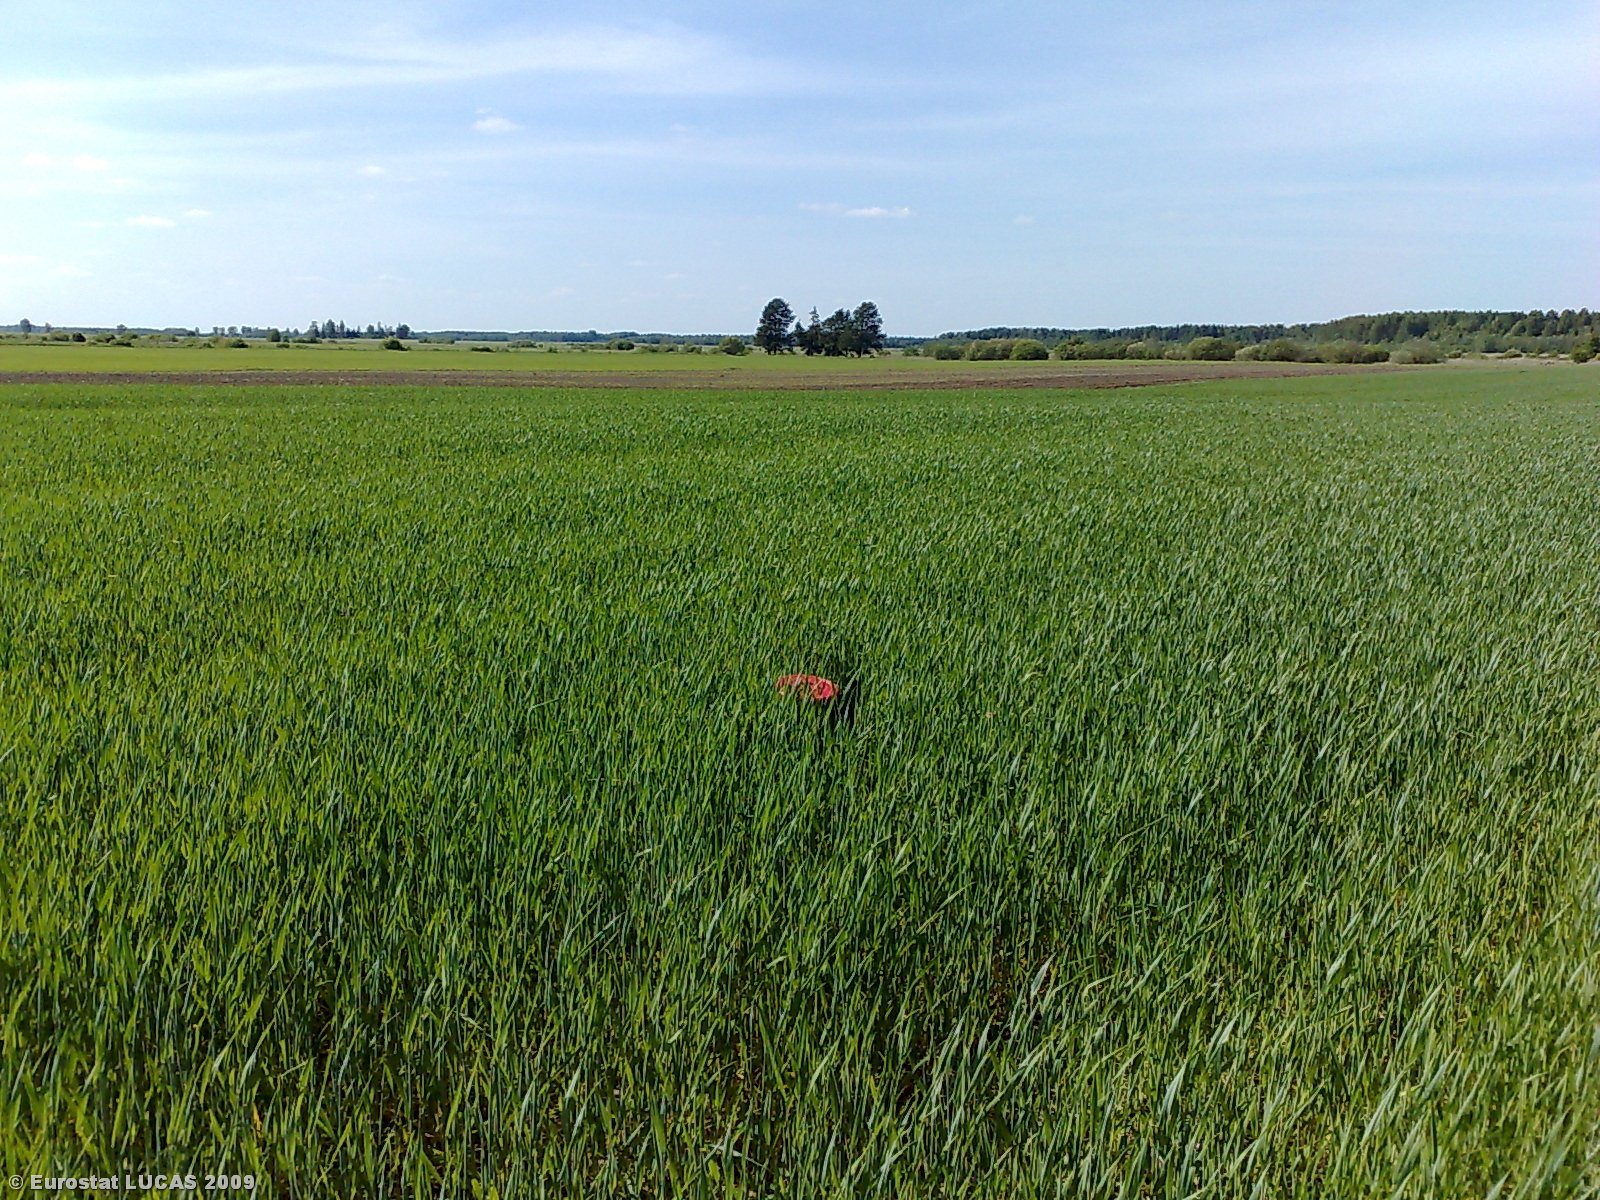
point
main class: Cropland
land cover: Common wheat
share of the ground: > 75 %
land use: Agriculture (excluding fallow land and kitchen gardens)
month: May
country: LT
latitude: 56.4004
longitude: 22.9795
